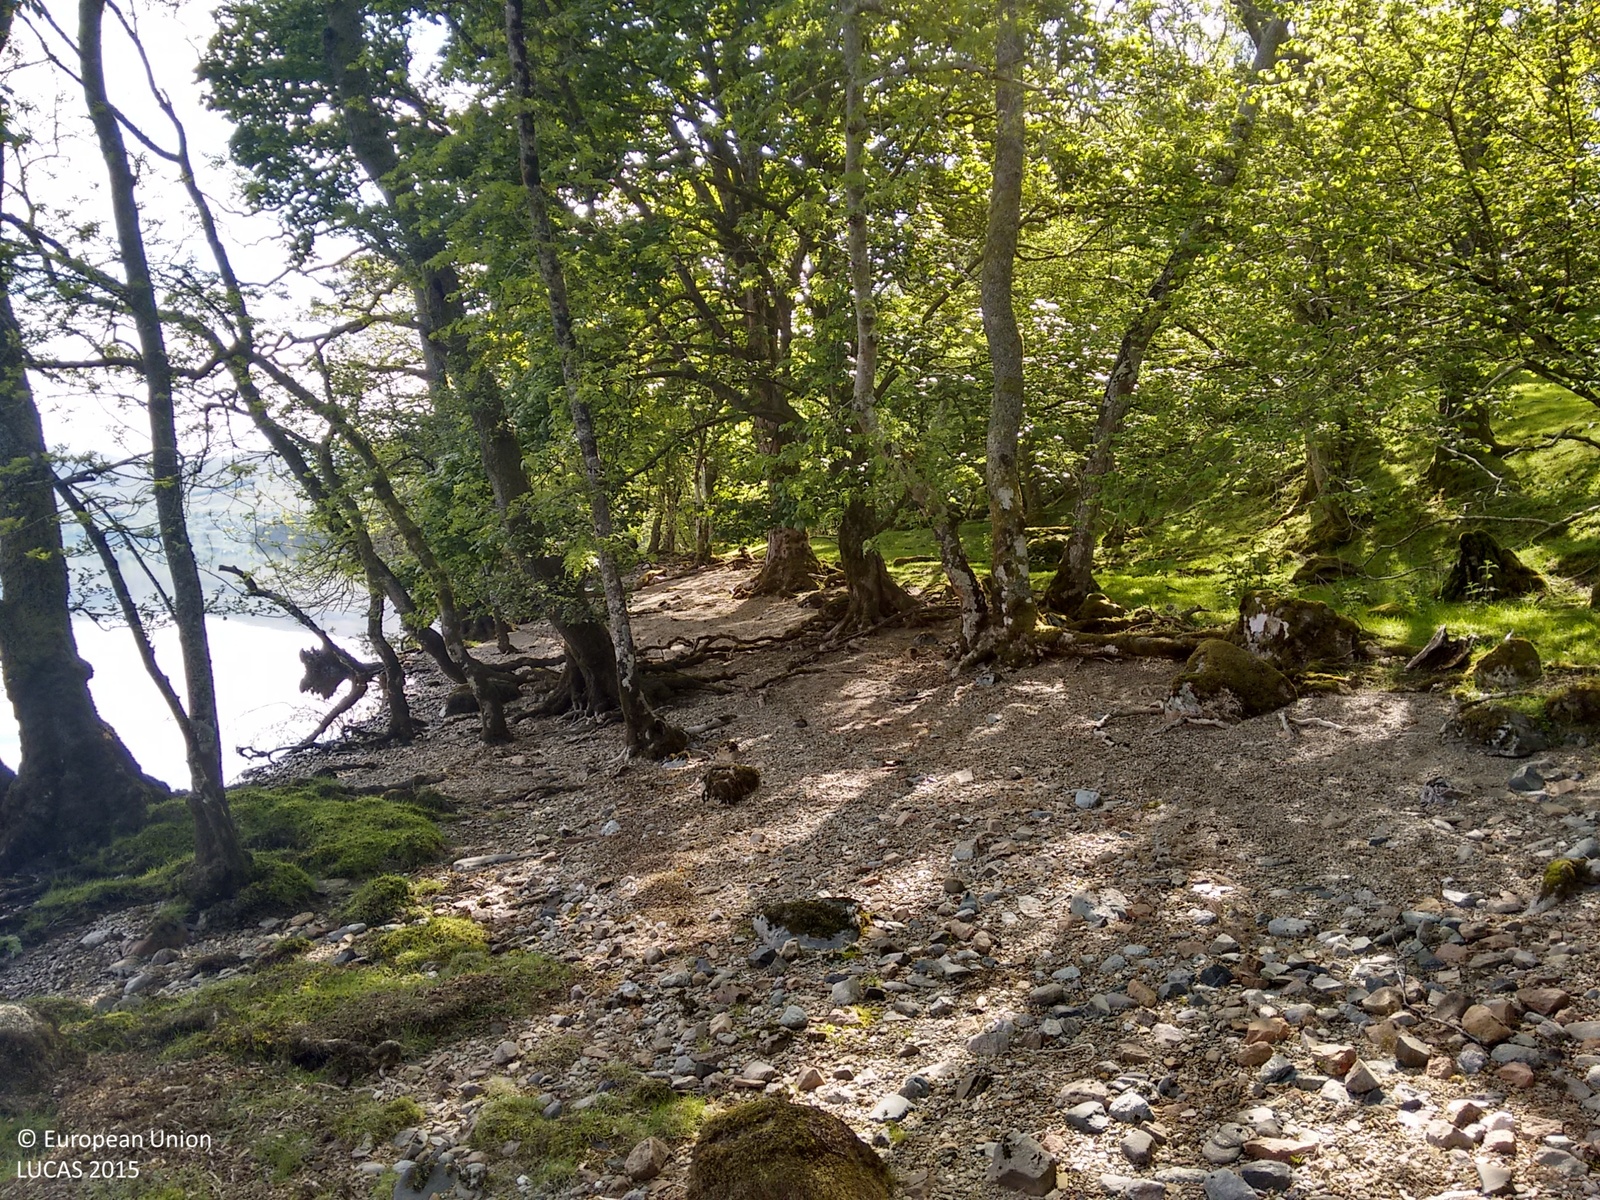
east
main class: Woodland
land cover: Broadleaved woodland
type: mesophytic deciduous forest
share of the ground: > 75 %
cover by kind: broadleaved forest trees 90 %, unconsolidated bare surface 10 %
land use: Agriculture (excluding fallow land and kitchen gardens)
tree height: > 5 m
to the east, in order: Broadleaved woodland; Rivers and streams; Broadleaved woodland; Fences; Broadleaved woodland; Rivers and streams; Broadleaved woodland; Inland fresh water bodies
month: June
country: GB
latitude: 56.4897
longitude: -4.2028
